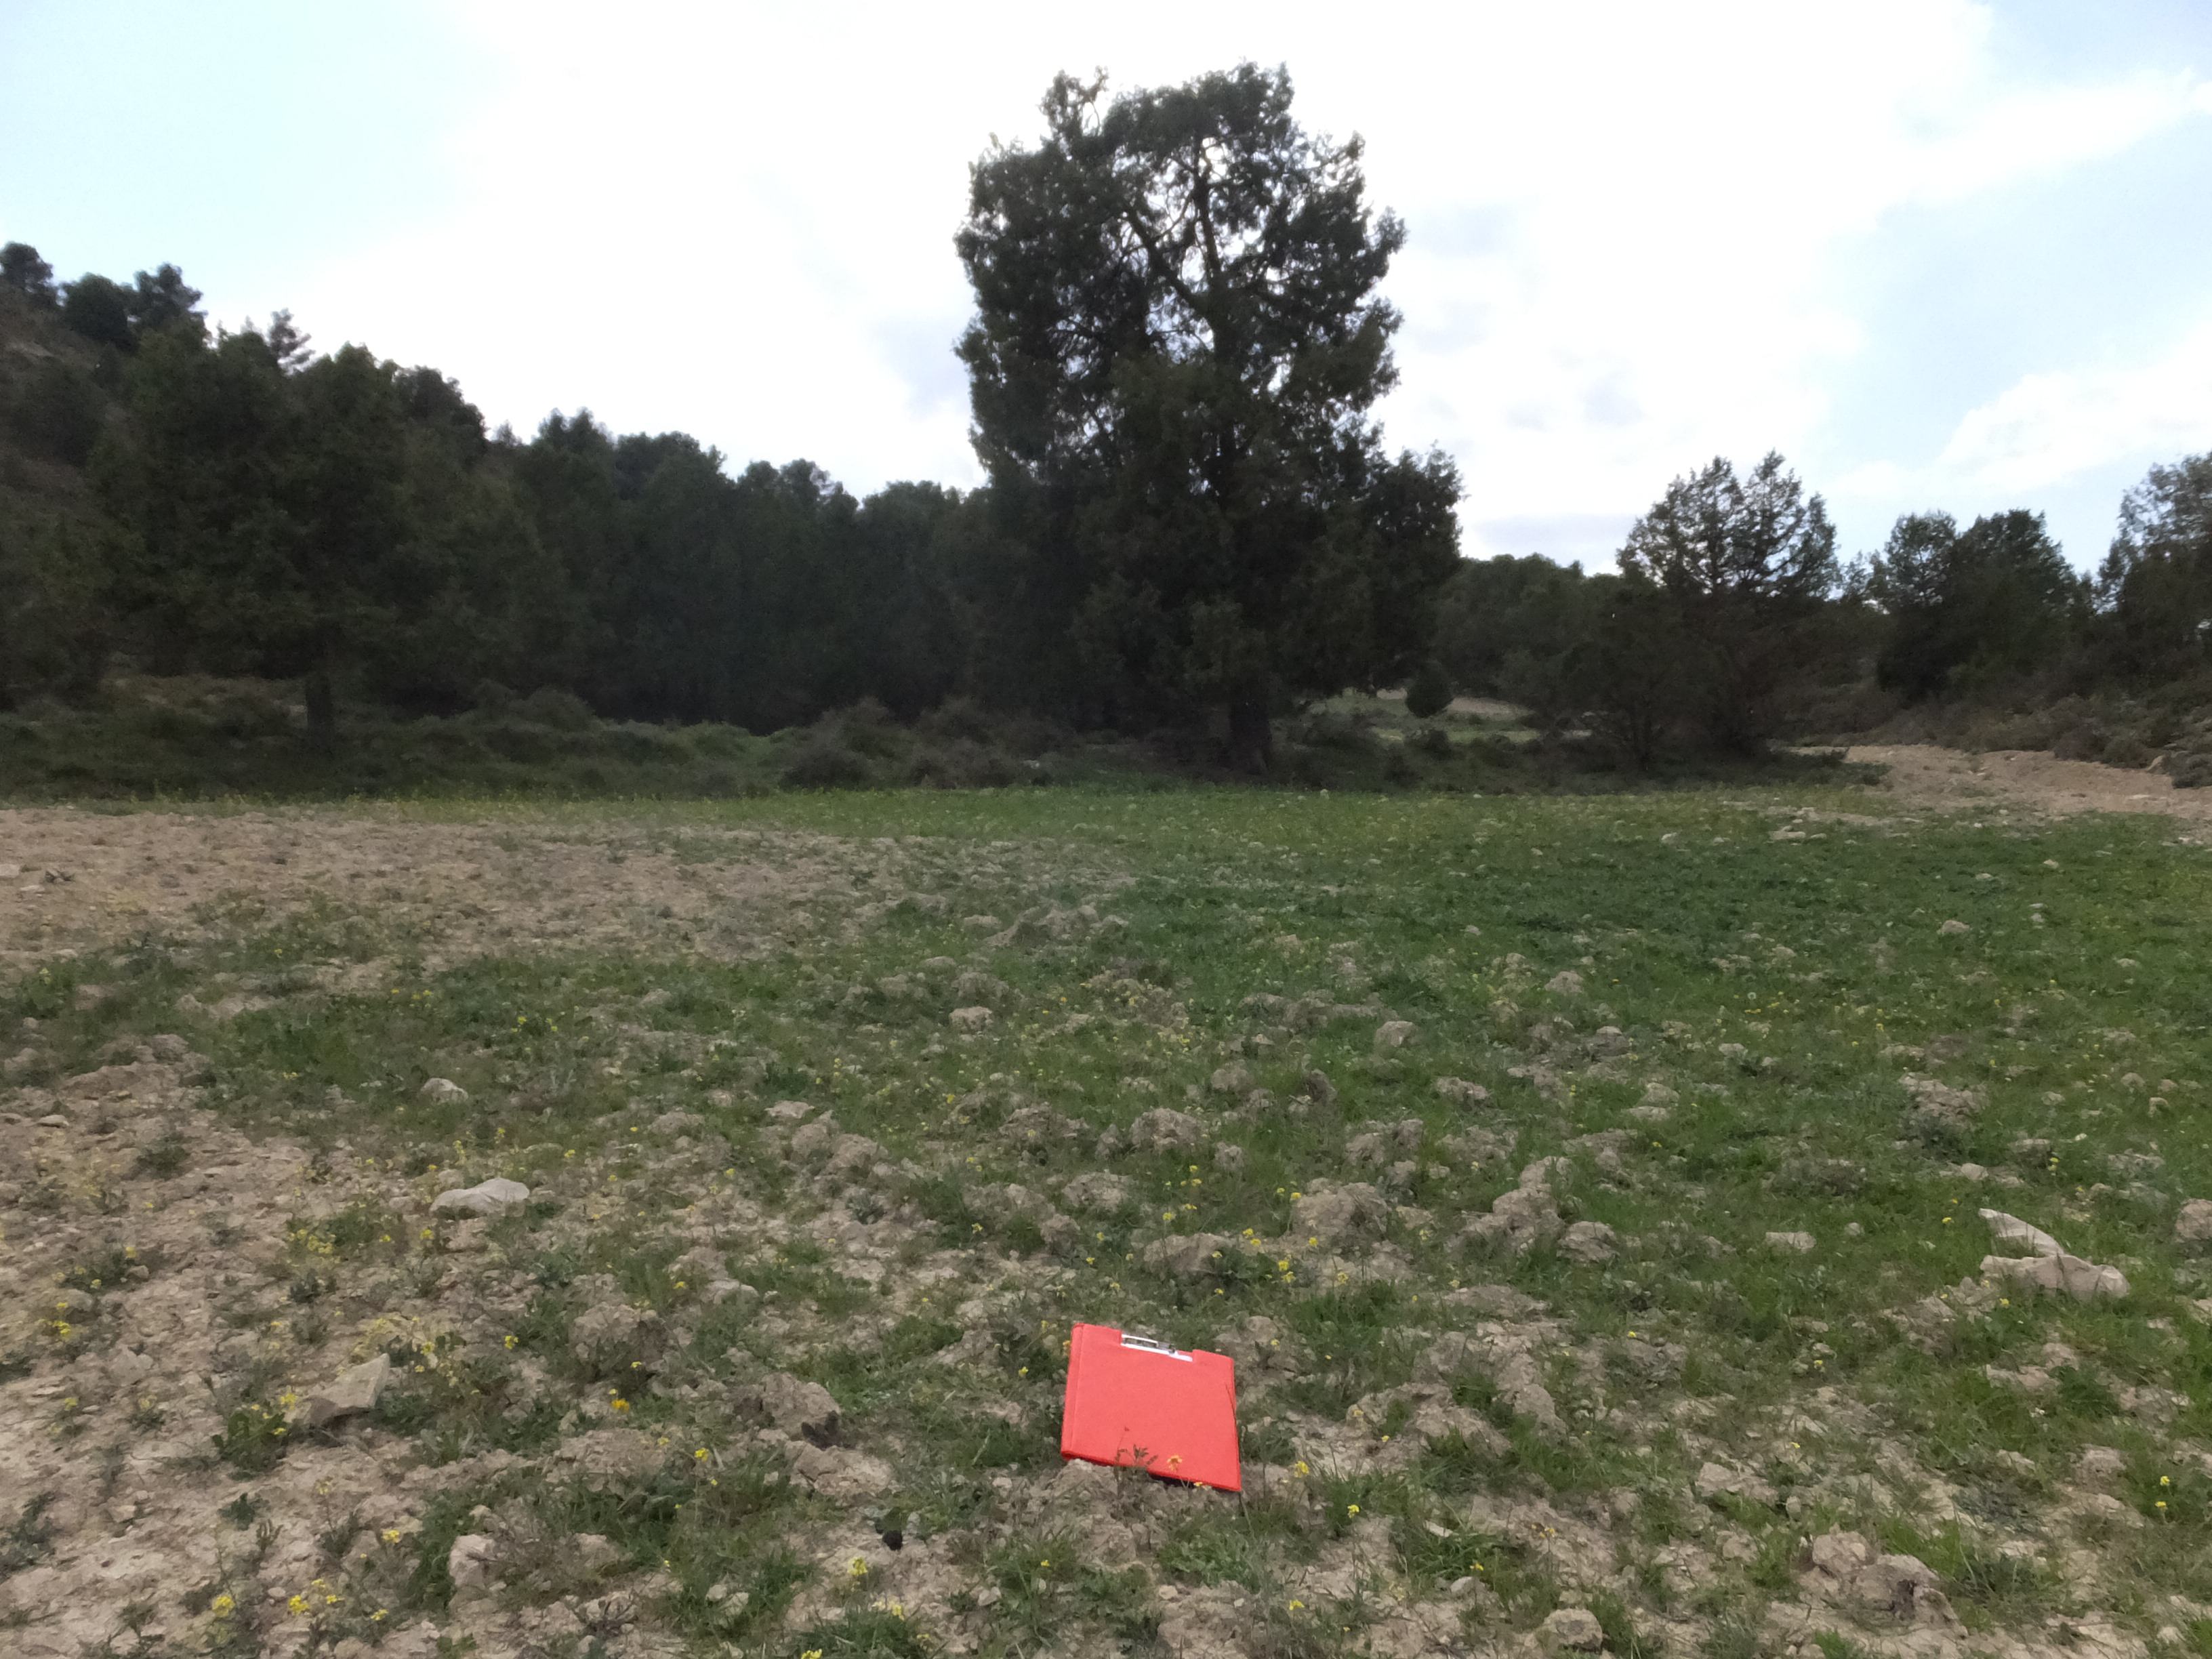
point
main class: Grassland
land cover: Spontaneously vegetated surfaces
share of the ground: 50 - 75 %
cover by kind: herbaceous plants 50 %, unconsolidated bare surface 50 %
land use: Agriculture (excluding fallow land and kitchen gardens)
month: April
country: ES
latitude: 41.7177
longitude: -0.3920
